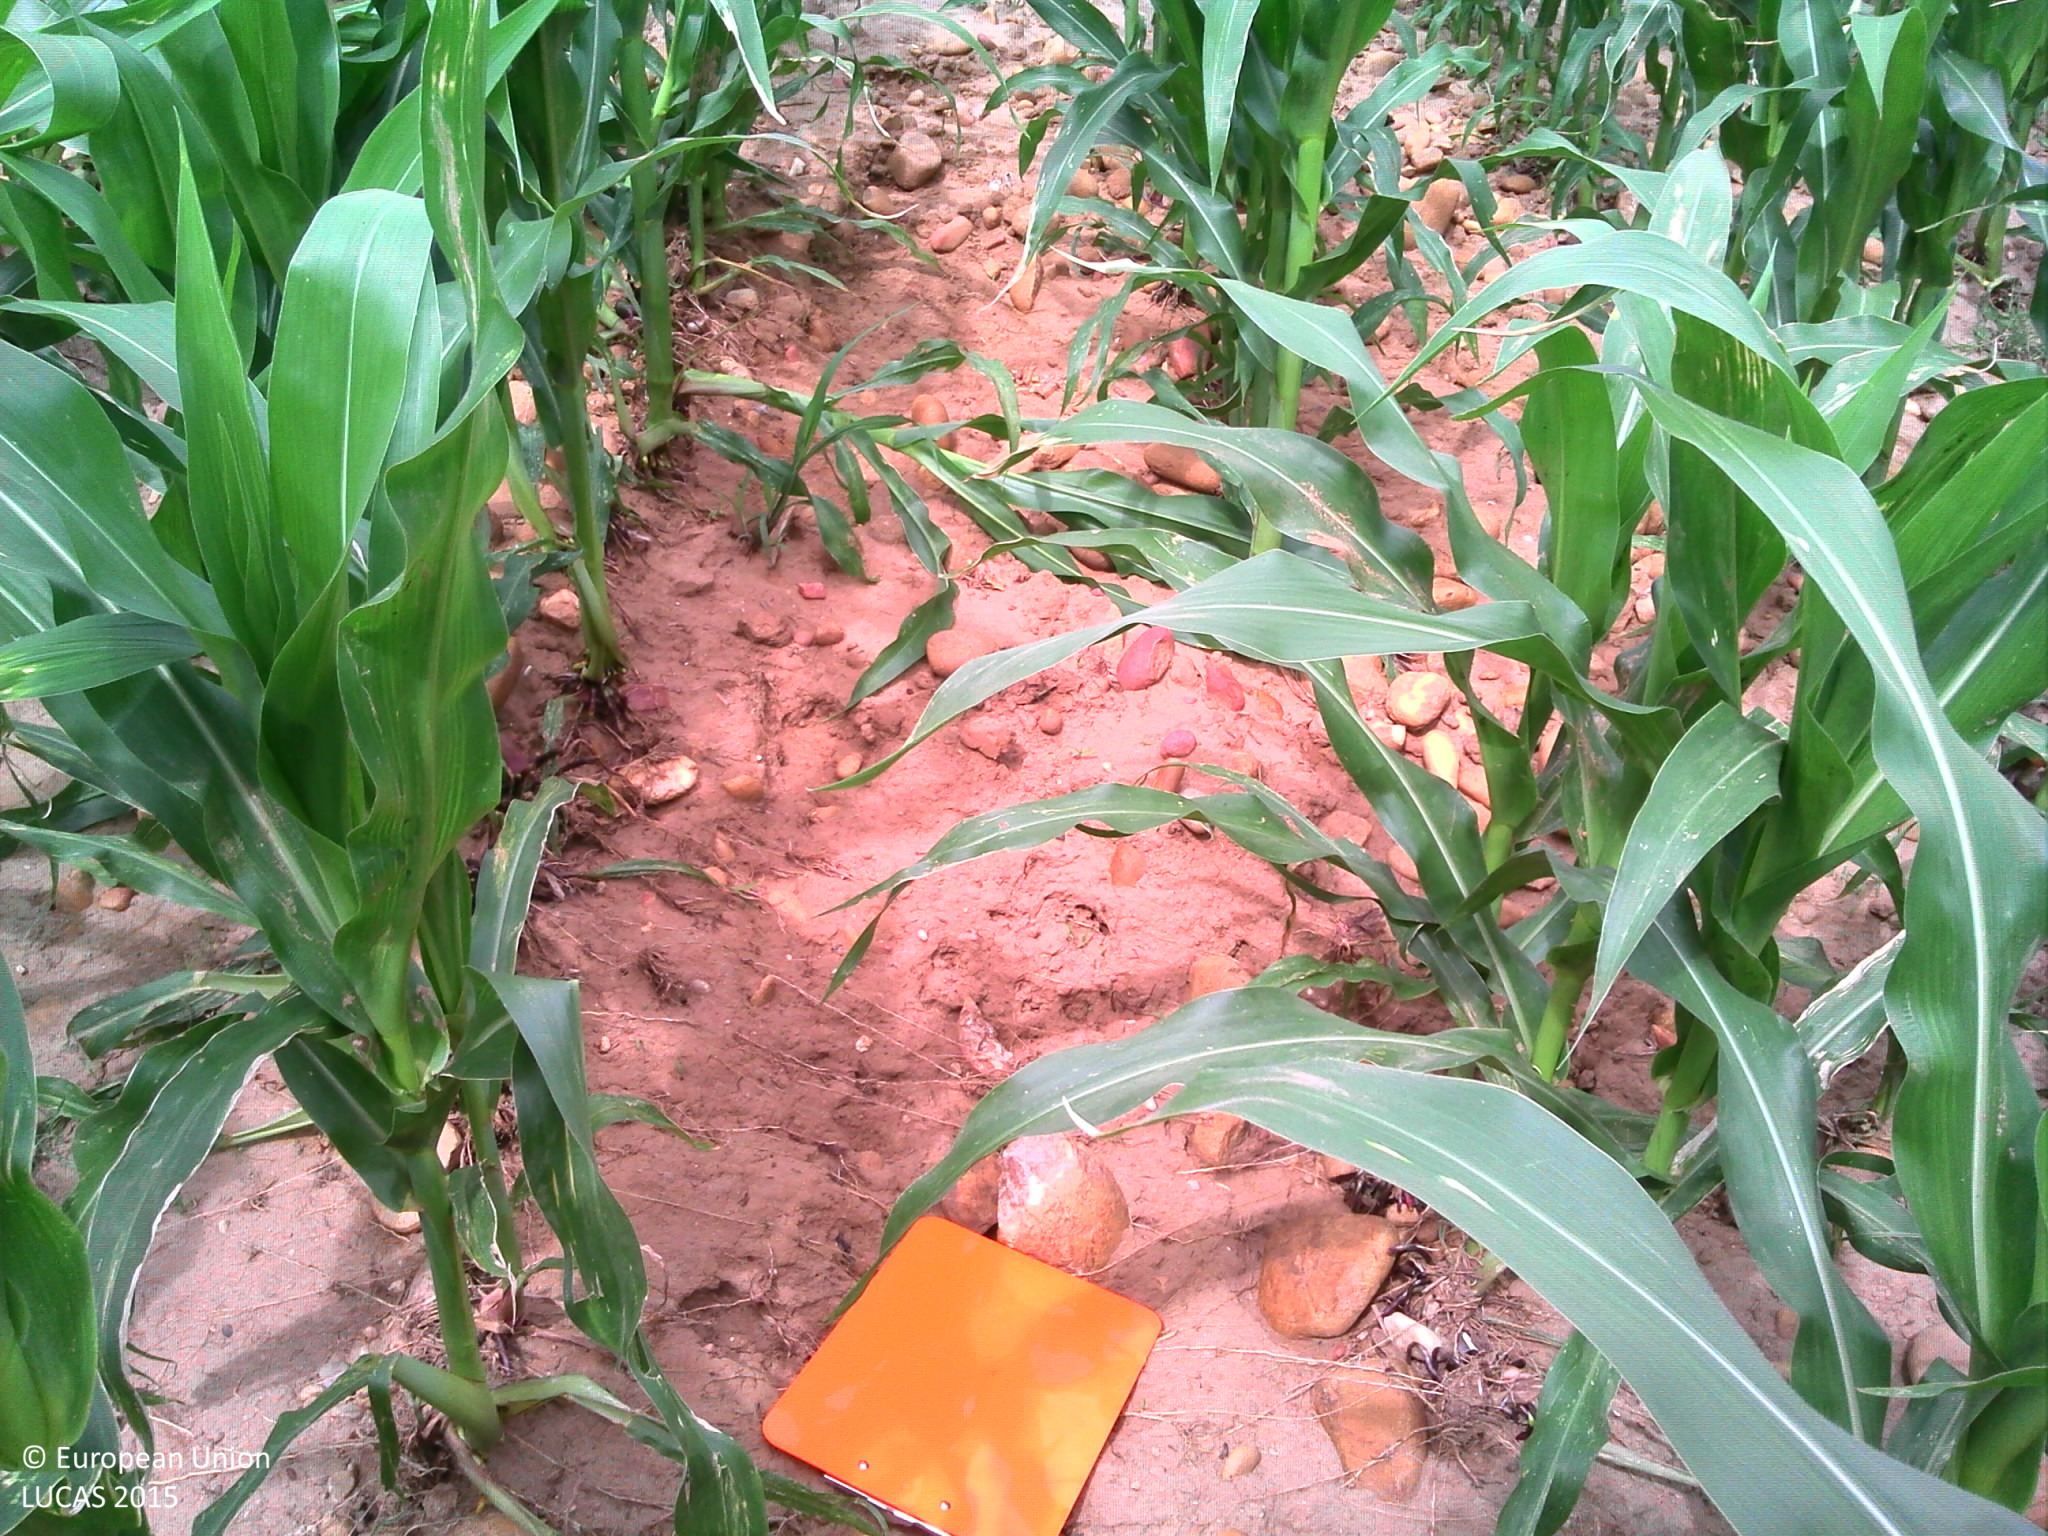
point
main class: Cropland
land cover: Maize
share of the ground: > 75 %
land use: Agriculture (excluding fallow land and kitchen gardens)
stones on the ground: 25 - 50 %
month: June
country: FR
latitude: 45.1647
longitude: 4.9035
